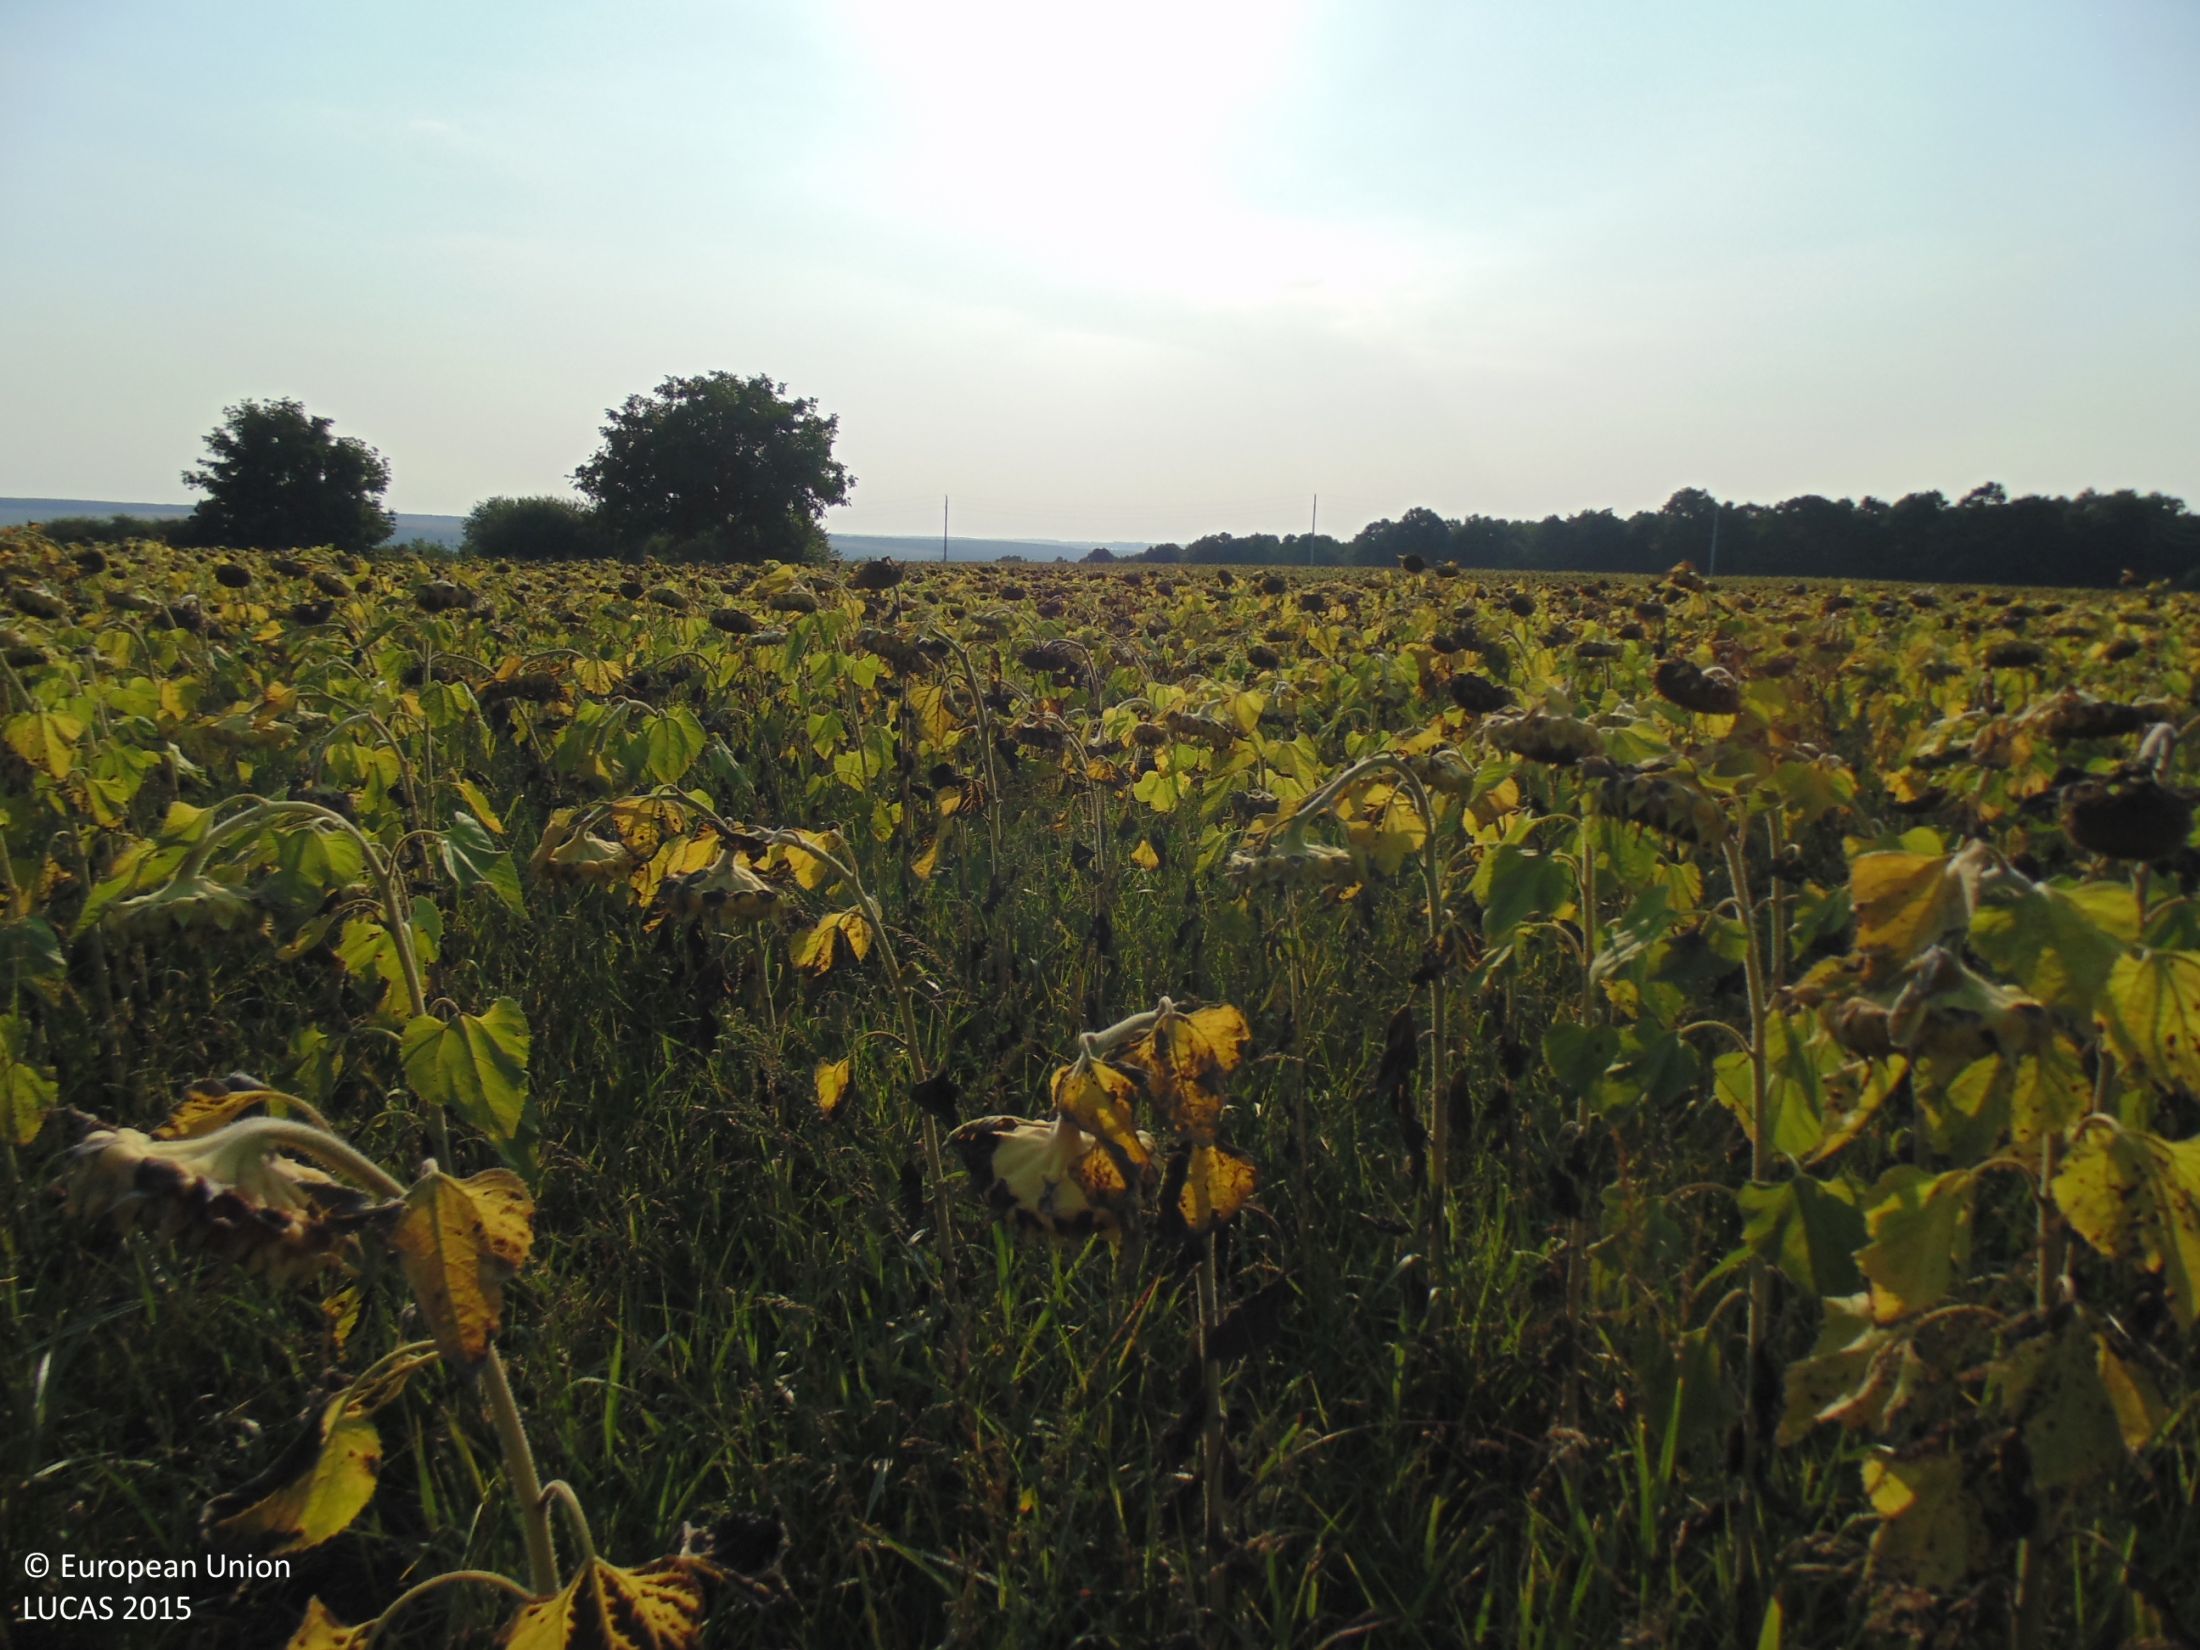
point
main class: Cropland
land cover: Sunflower
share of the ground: > 75 %
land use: Agriculture (excluding fallow land and kitchen gardens)
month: August
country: BG
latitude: 43.8538
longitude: 27.3358
